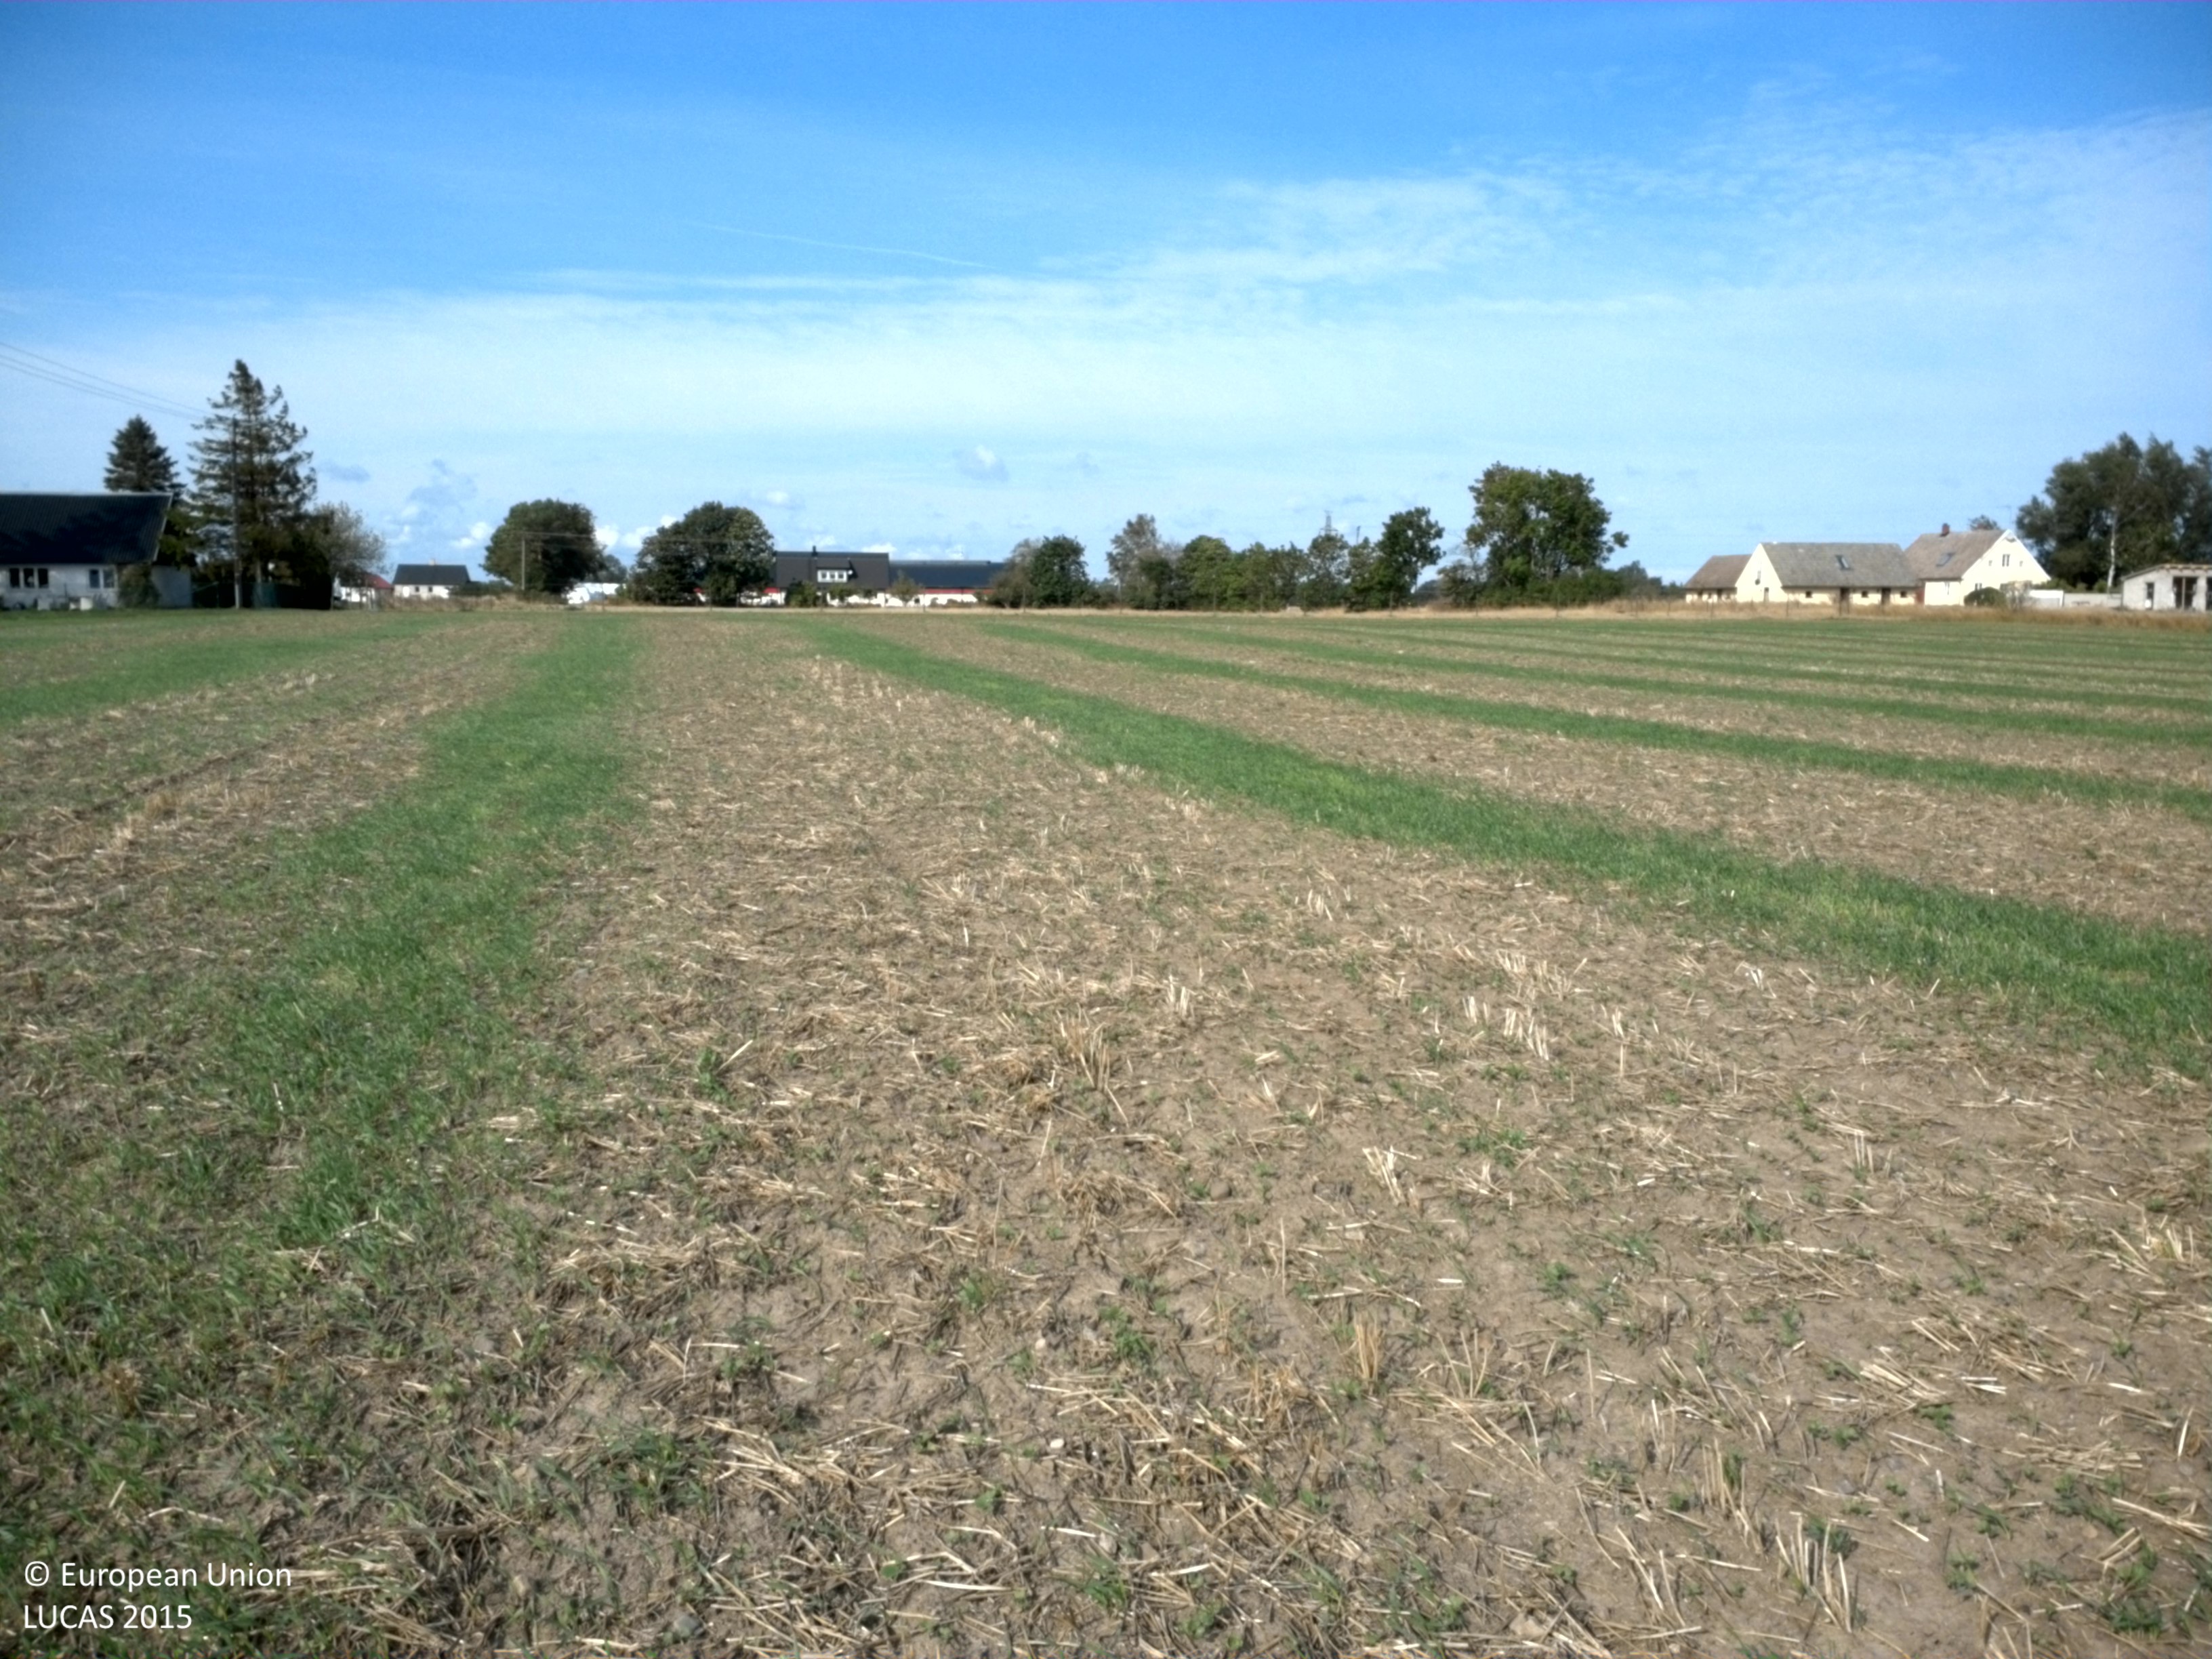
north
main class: Cropland
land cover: Other leguminous and mixtures for fodder
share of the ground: 10 - 25 %
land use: Agriculture (excluding fallow land and kitchen gardens)
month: September
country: SE
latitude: 55.5303
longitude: 14.0384
